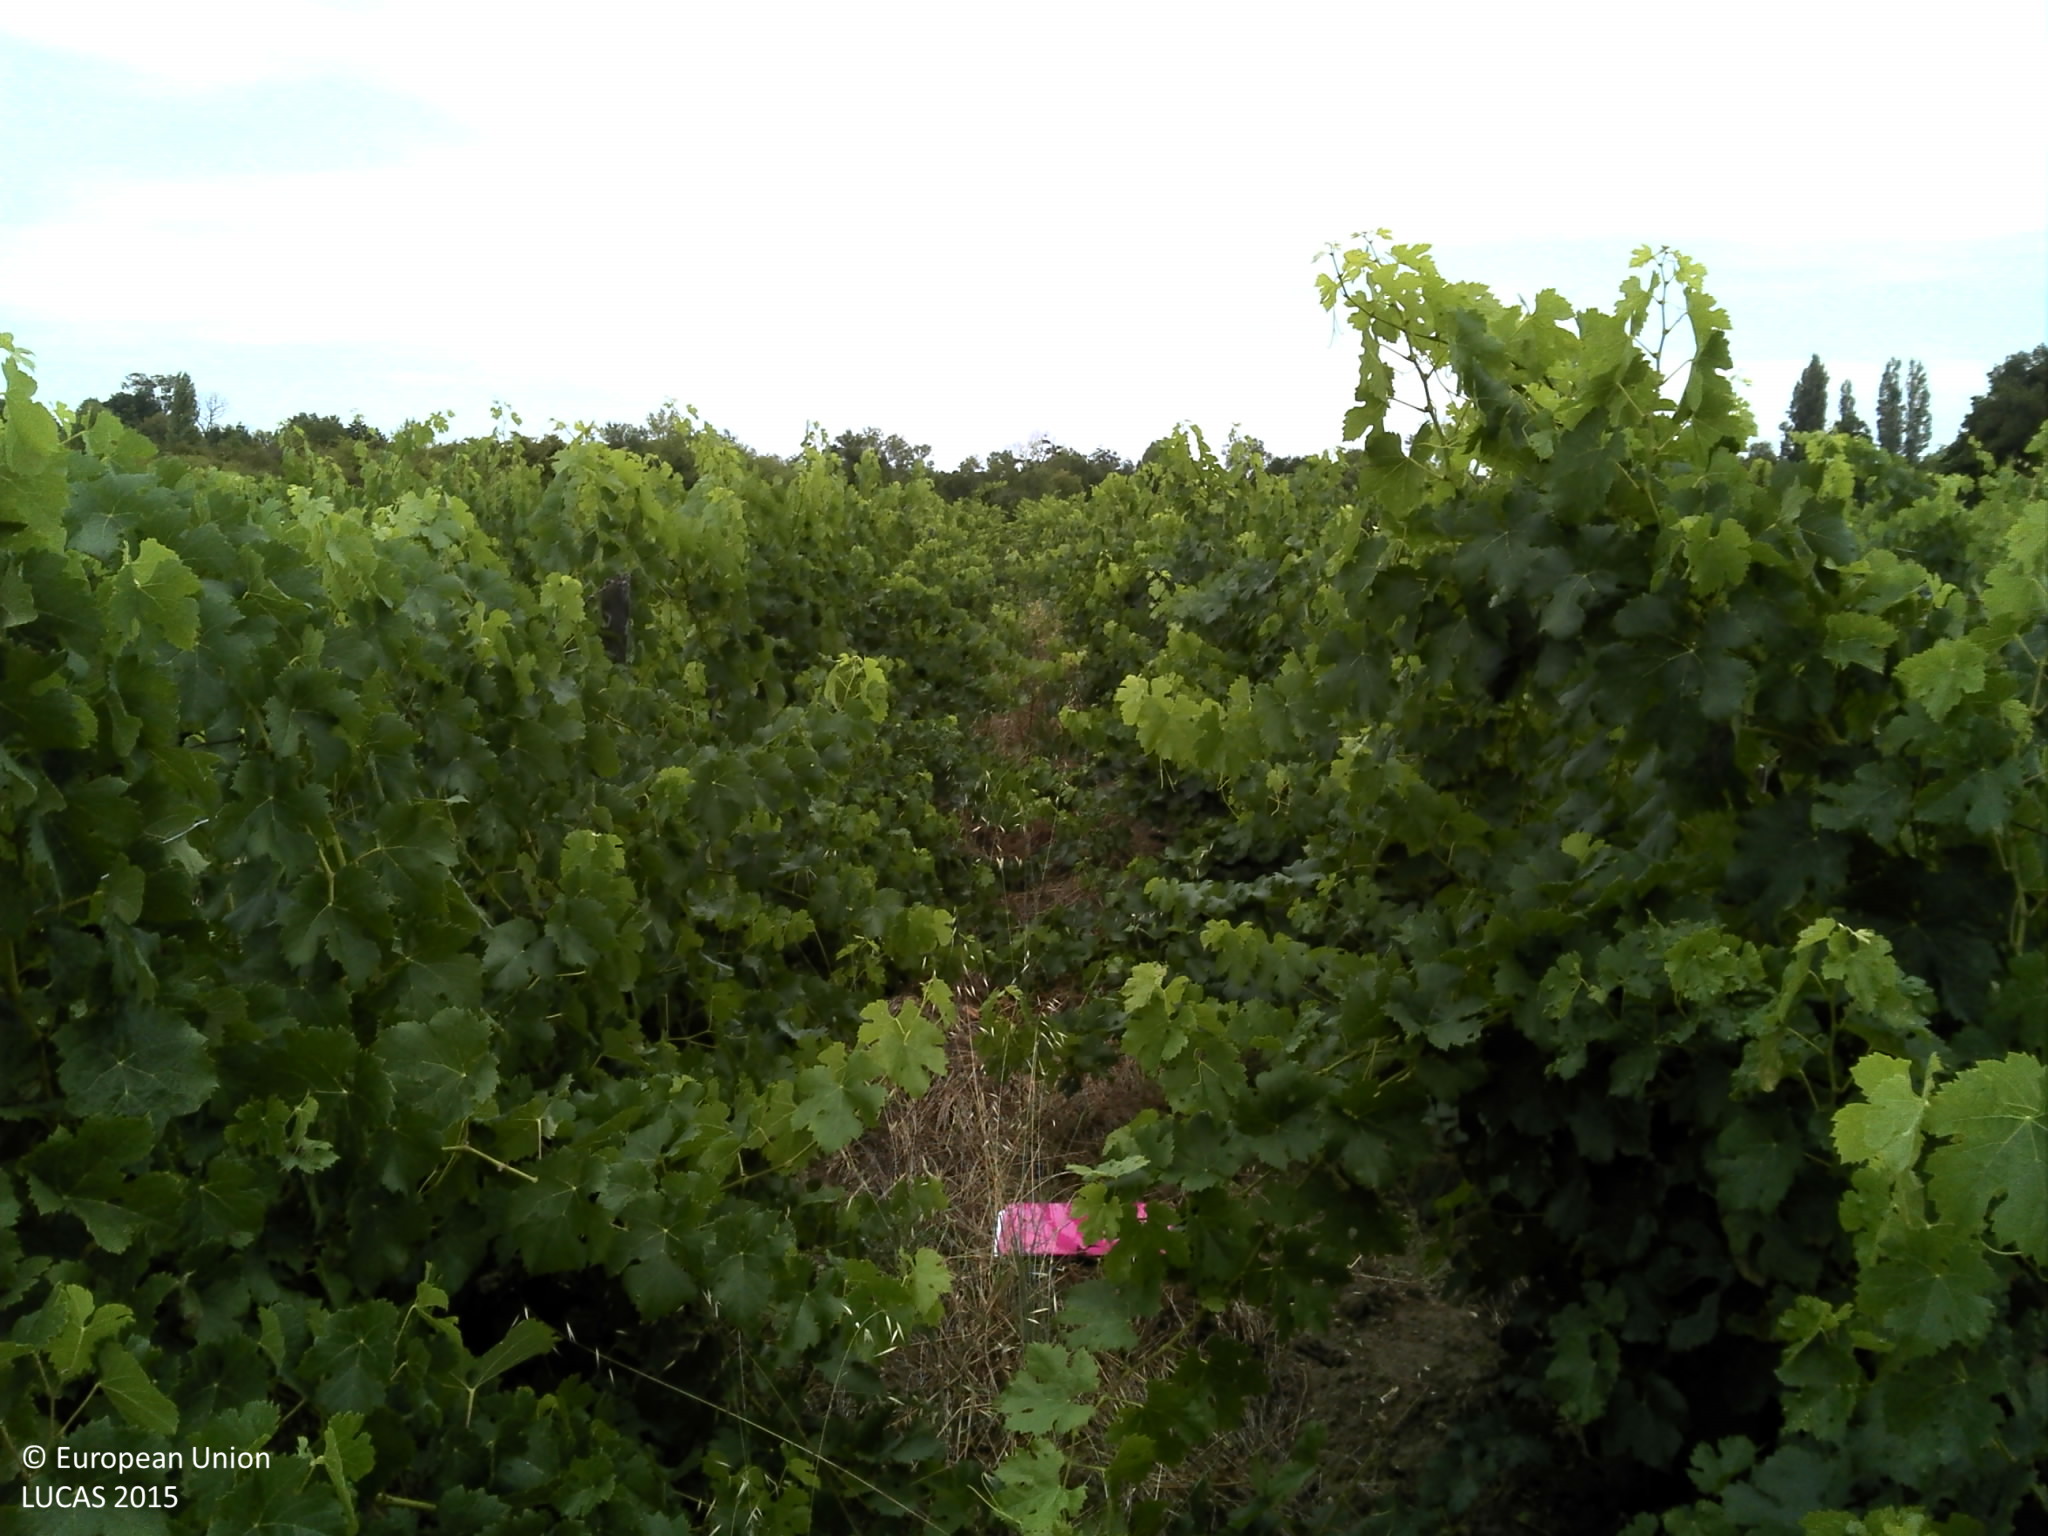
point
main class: Cropland
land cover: Vineyards
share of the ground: 50 - 75 %
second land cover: Grassland without tree/shrub cover
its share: 25 - 50 %
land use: Agriculture (excluding fallow land and kitchen gardens)
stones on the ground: < 10 %
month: August
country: FR
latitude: 45.1697
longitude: -0.5938
